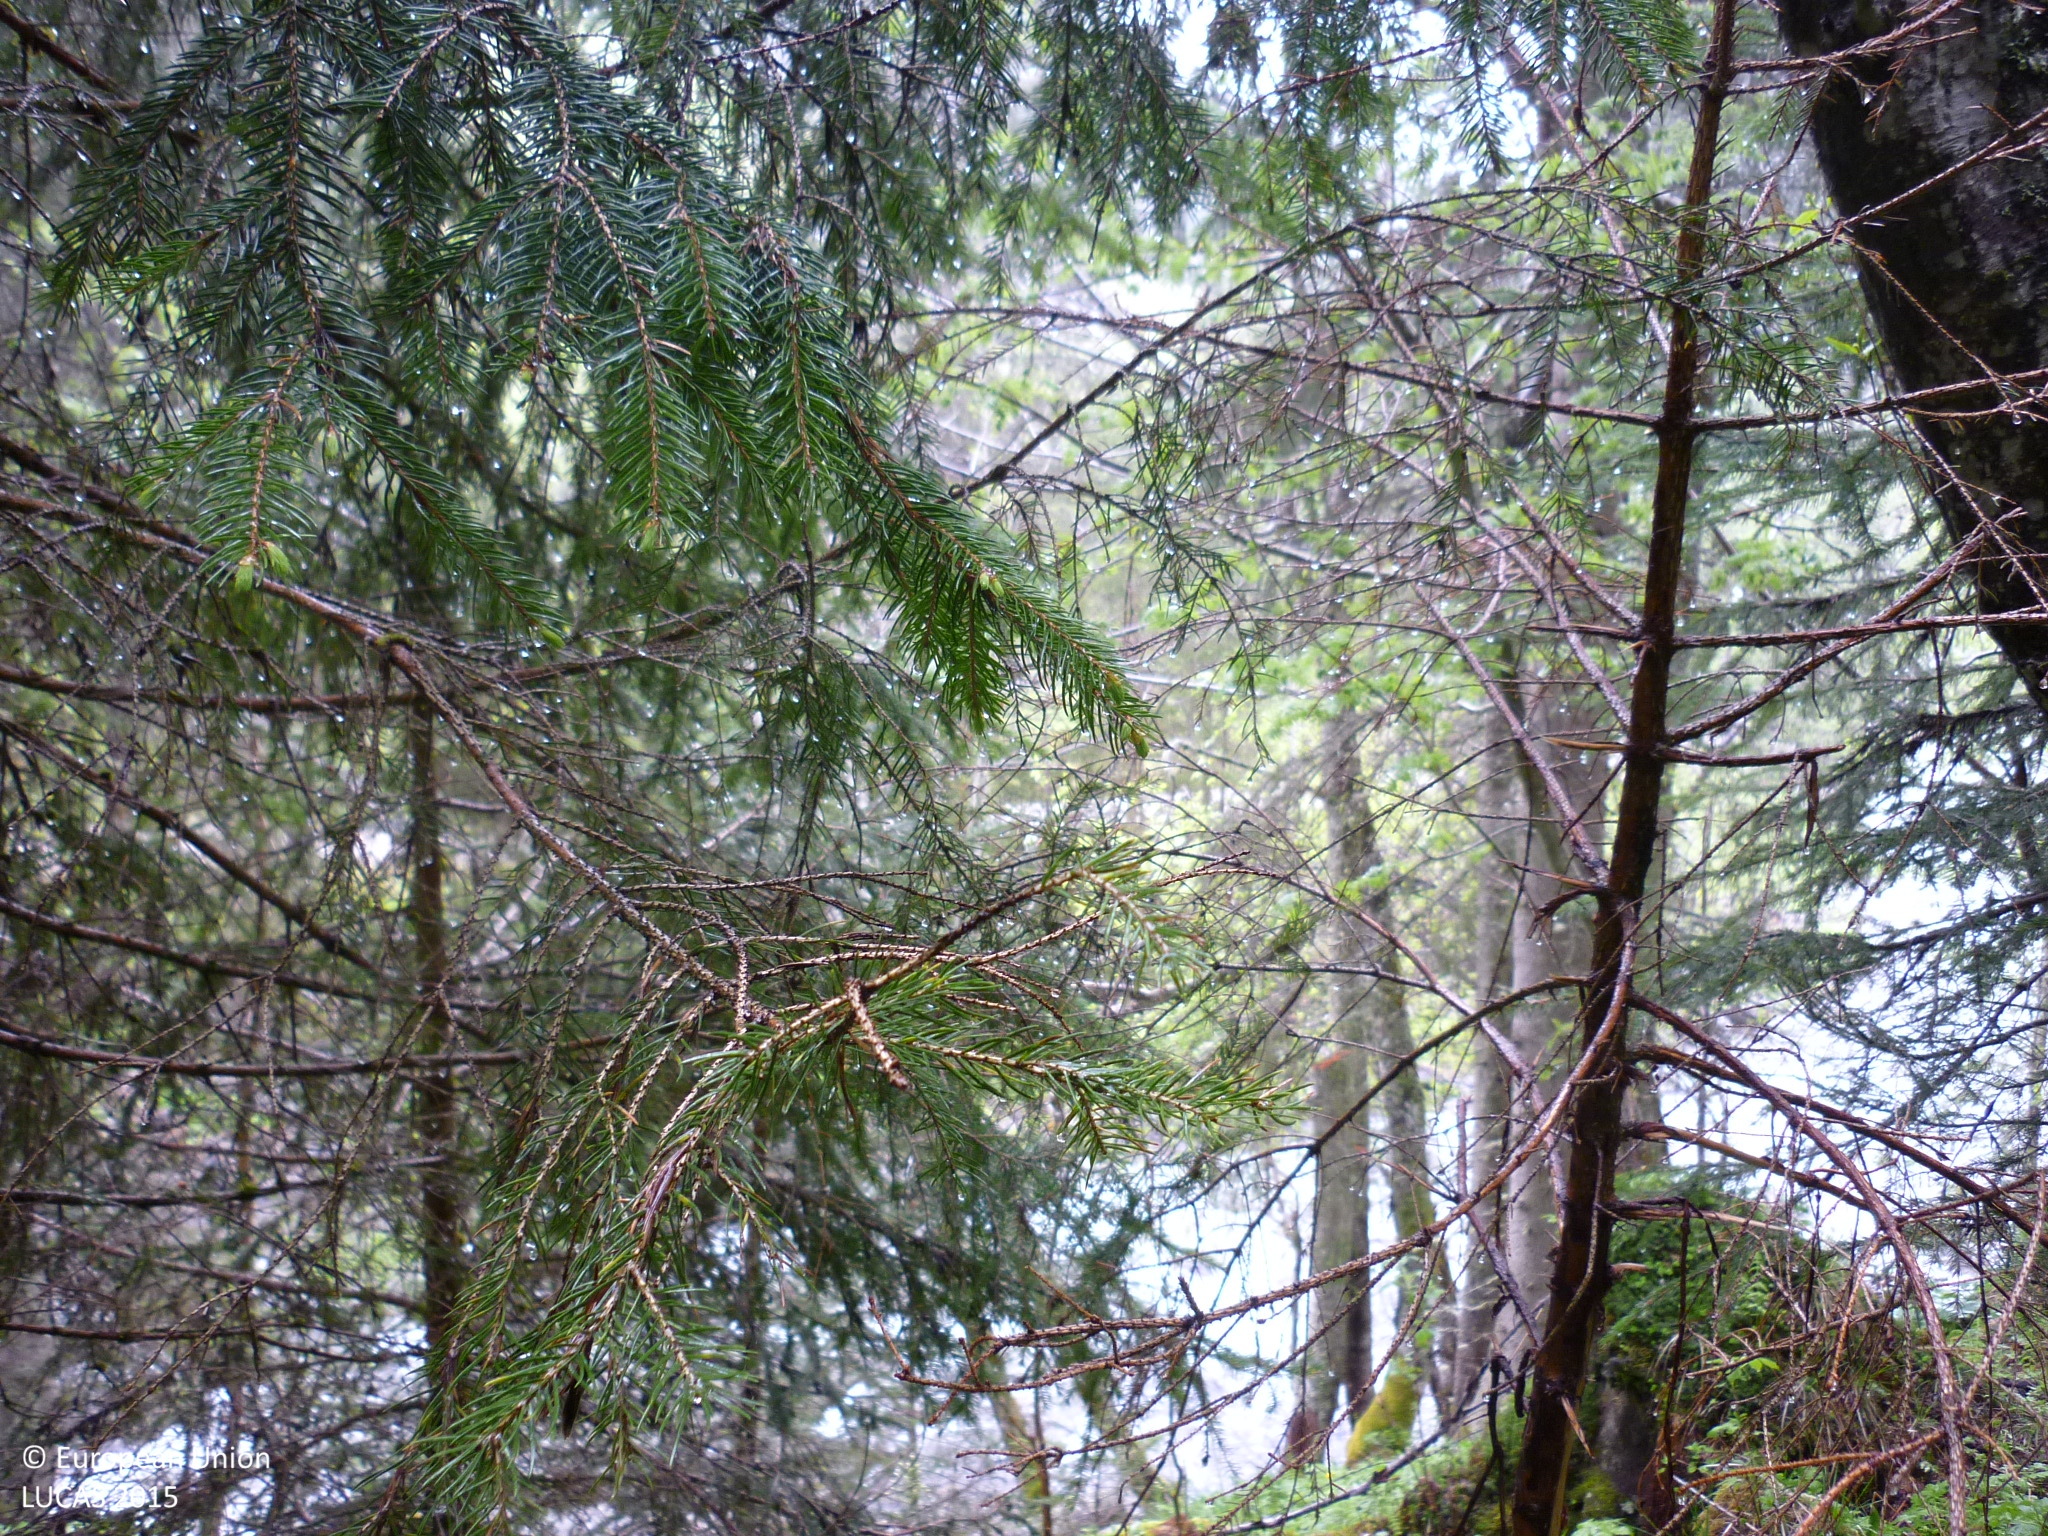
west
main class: Woodland
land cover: Spruce dominated coniferous woodland
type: alpine coniferous forest
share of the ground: > 75 %
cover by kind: coniferous forest trees 70 %, broadleaved forest trees 15 %, herbaceous plants 15 %
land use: Forestry
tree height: > 5 m
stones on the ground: < 10 %
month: May
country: AT
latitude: 47.3518
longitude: 14.1686
